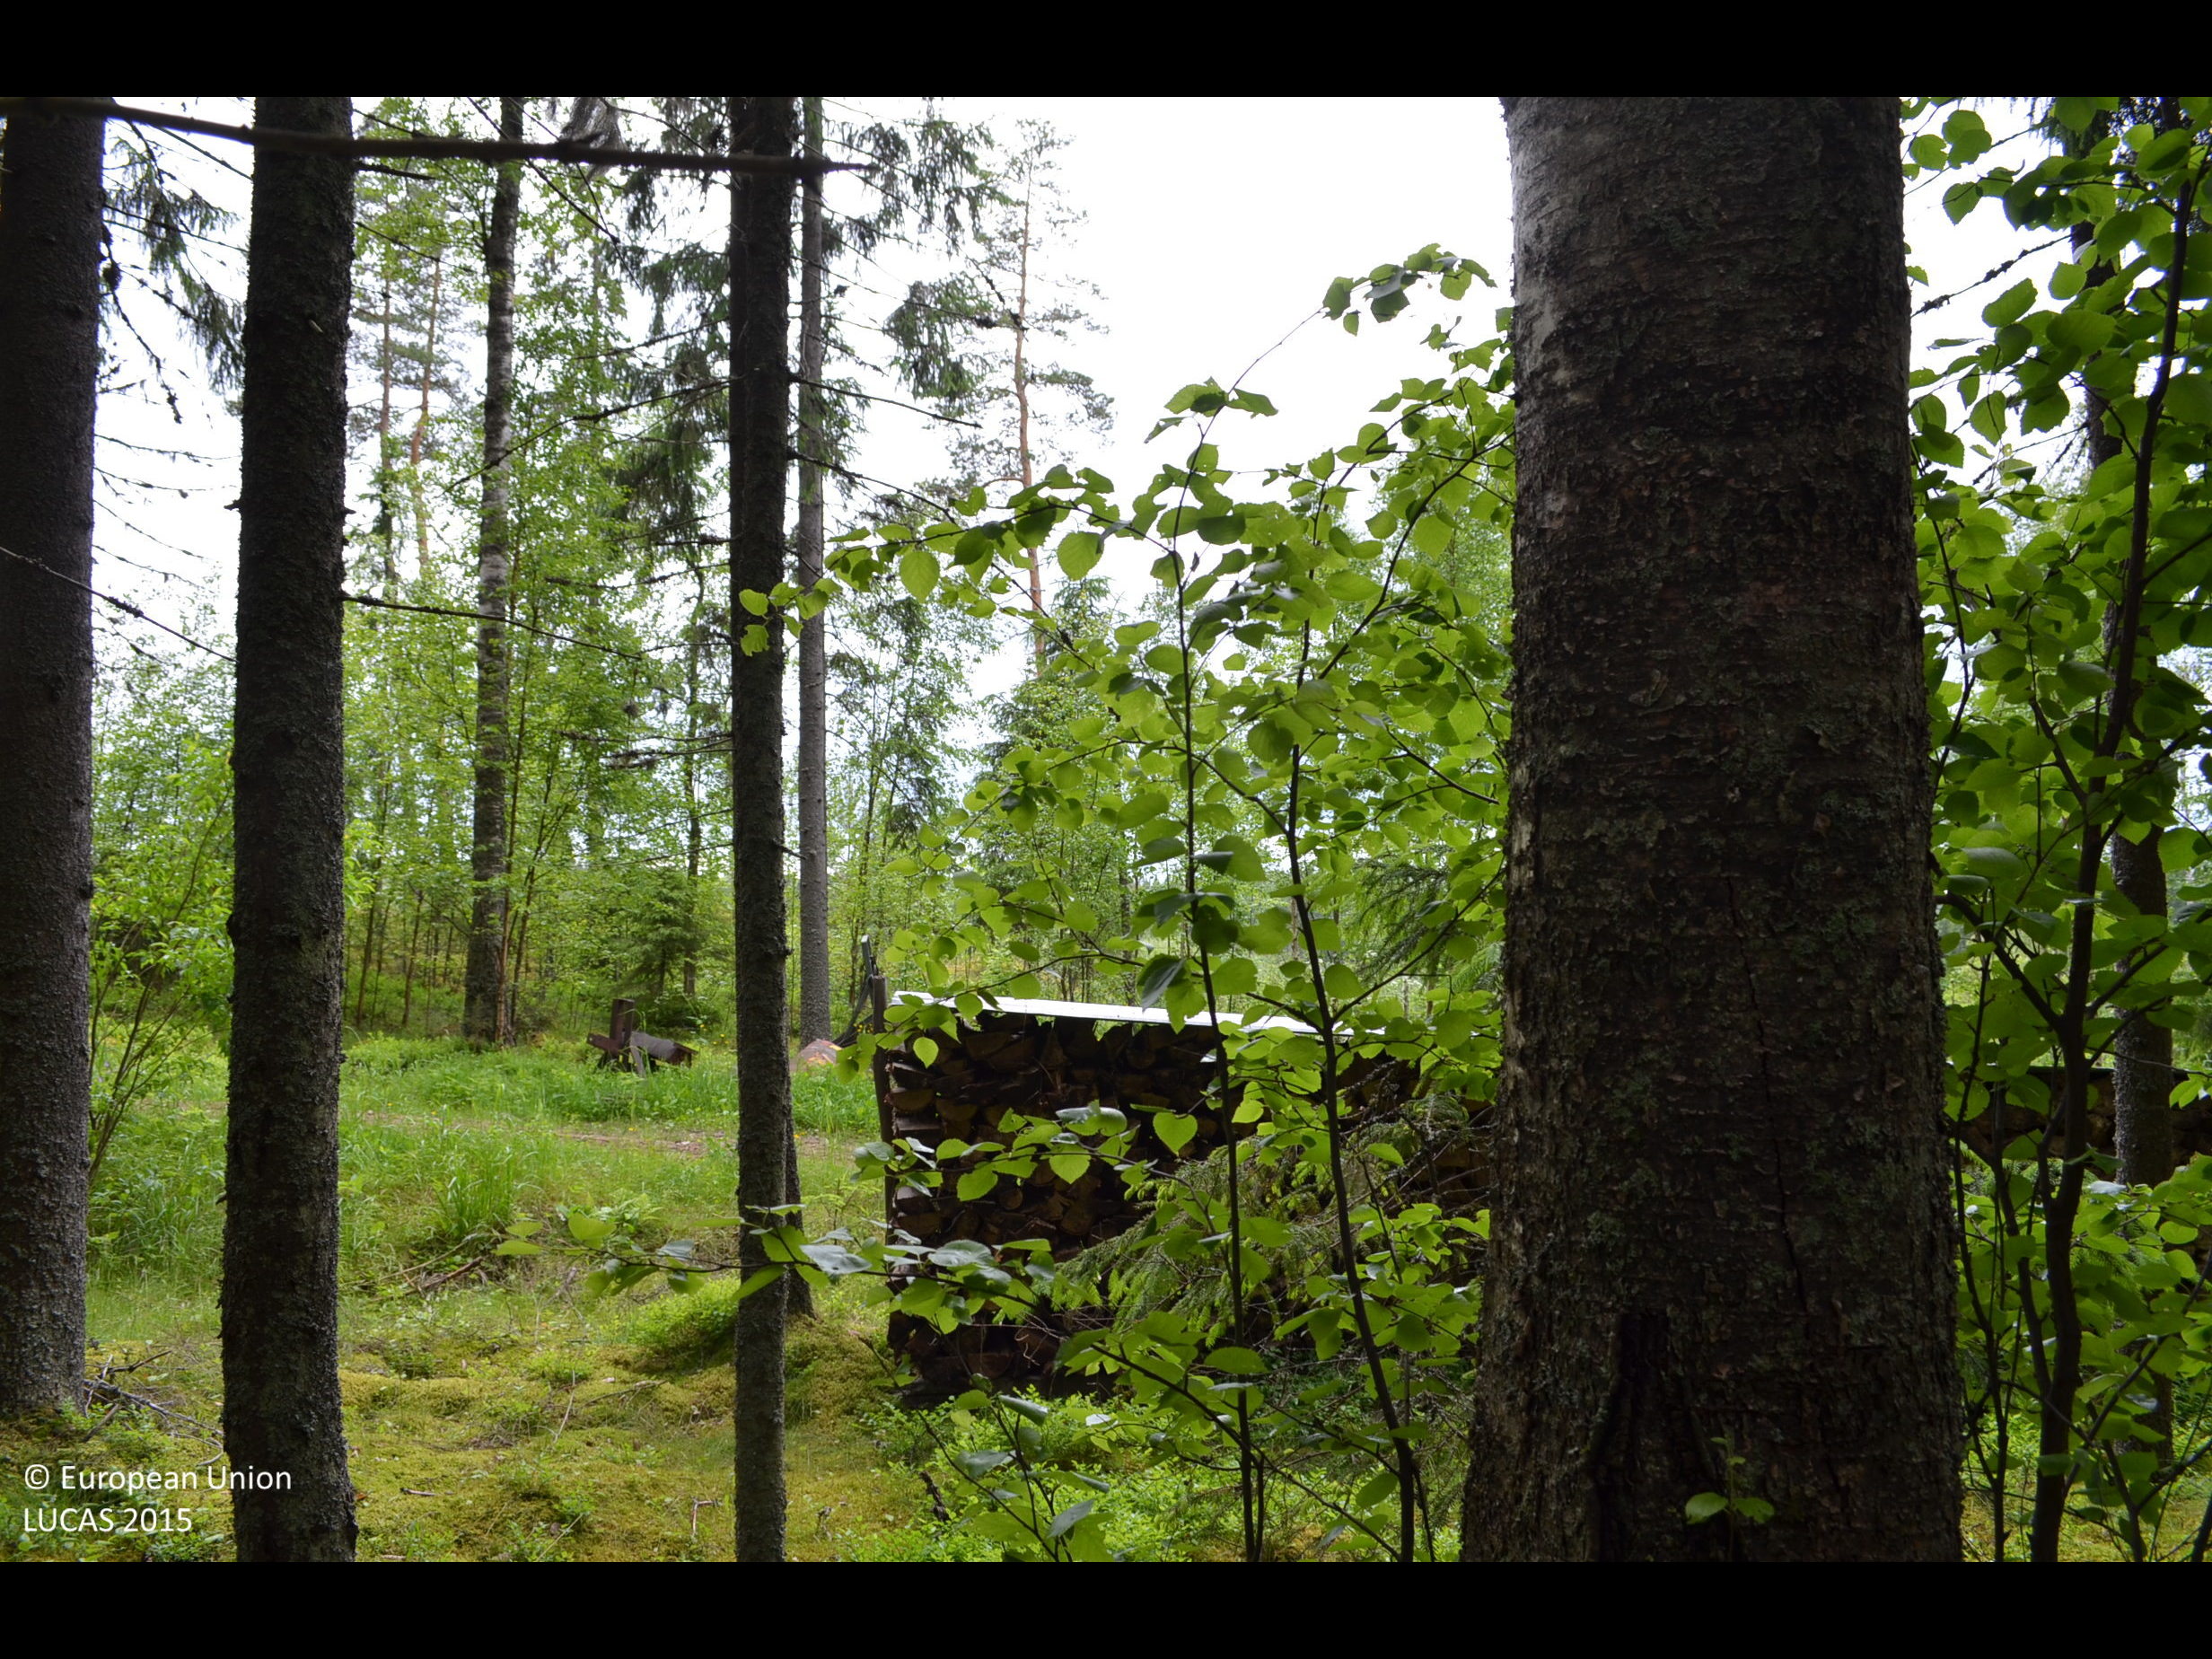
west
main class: Woodland
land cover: Other coniferous woodland
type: boreal forest
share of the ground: > 75 %
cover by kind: coniferous forest trees 85 %, broadleaved forest trees 5 %, herbaceous plants 5 %, lichens and mosses 5 %
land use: Forestry
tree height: > 5 m
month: June
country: FI
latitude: 61.7751
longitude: 23.3617
